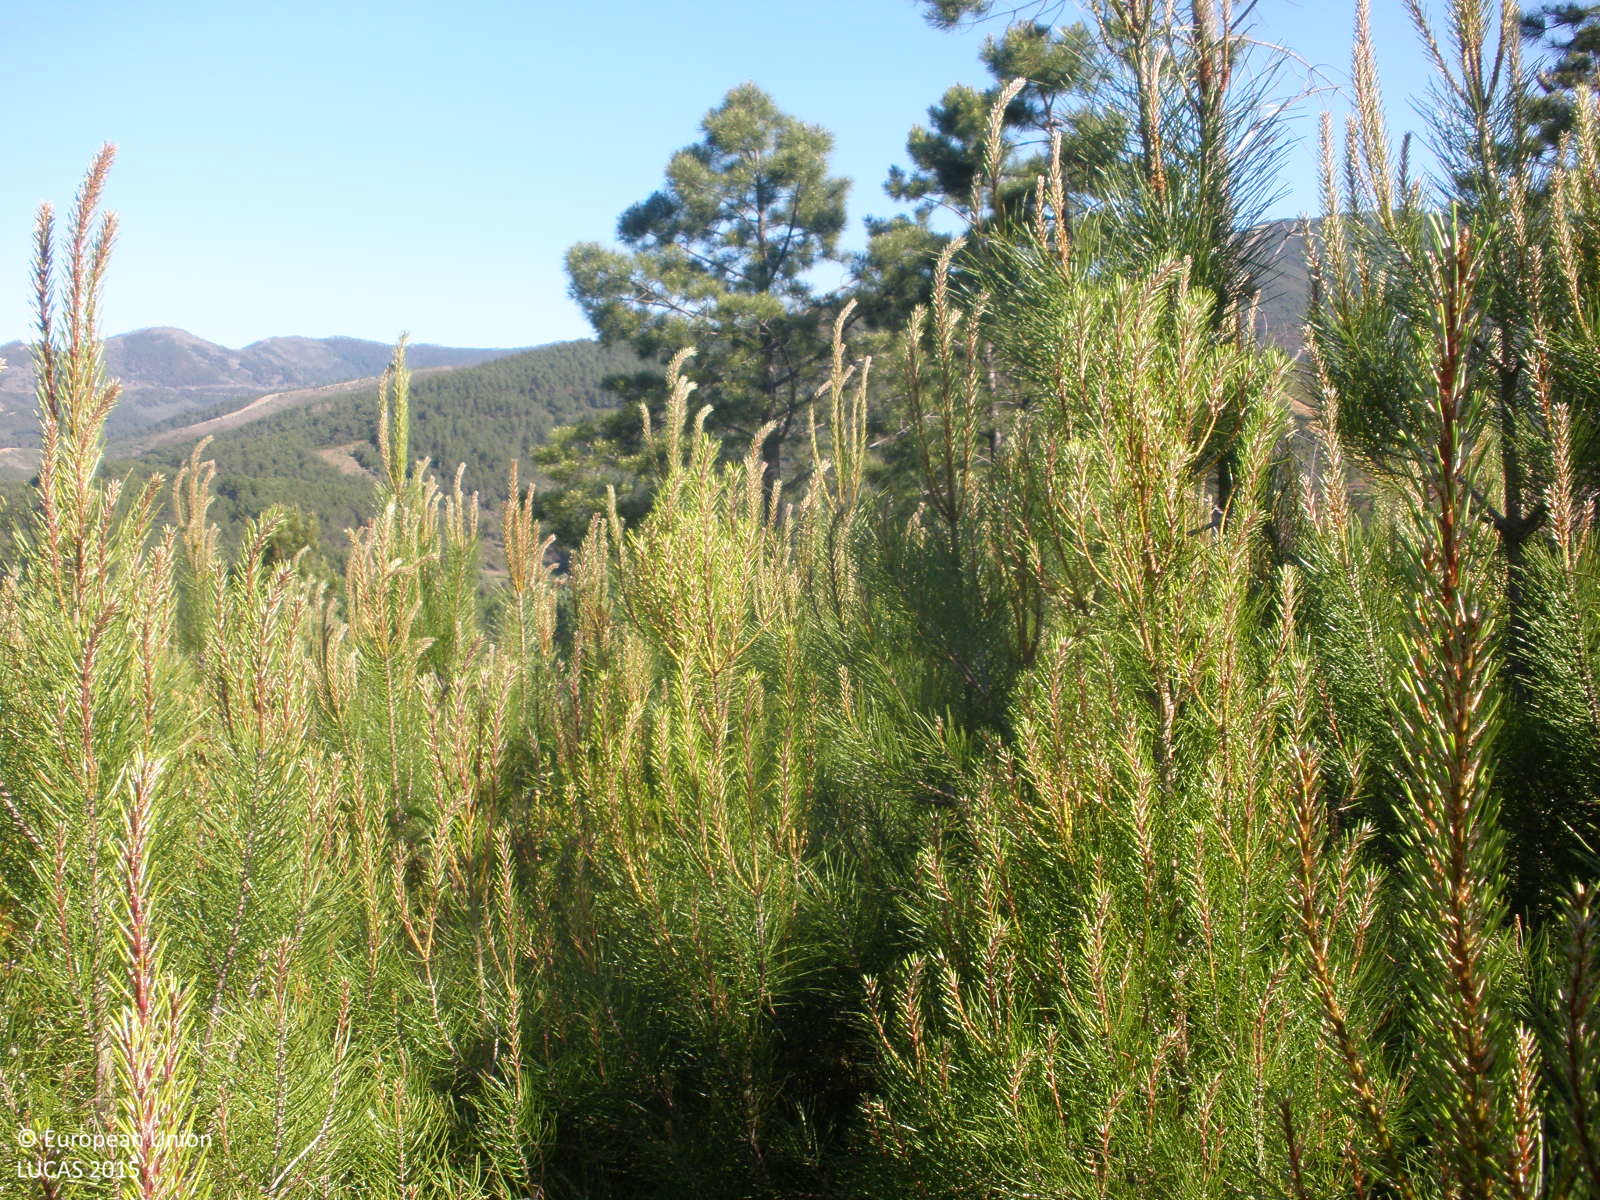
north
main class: Woodland
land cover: Pine dominated coniferous woodland
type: coniferous forest of the mediterranean region
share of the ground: > 75 %
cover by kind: coniferous forest trees 70 %, shrubs 30 %
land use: Forestry
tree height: < 5 m
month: May
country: ES
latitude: 40.4001
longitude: -6.2098
